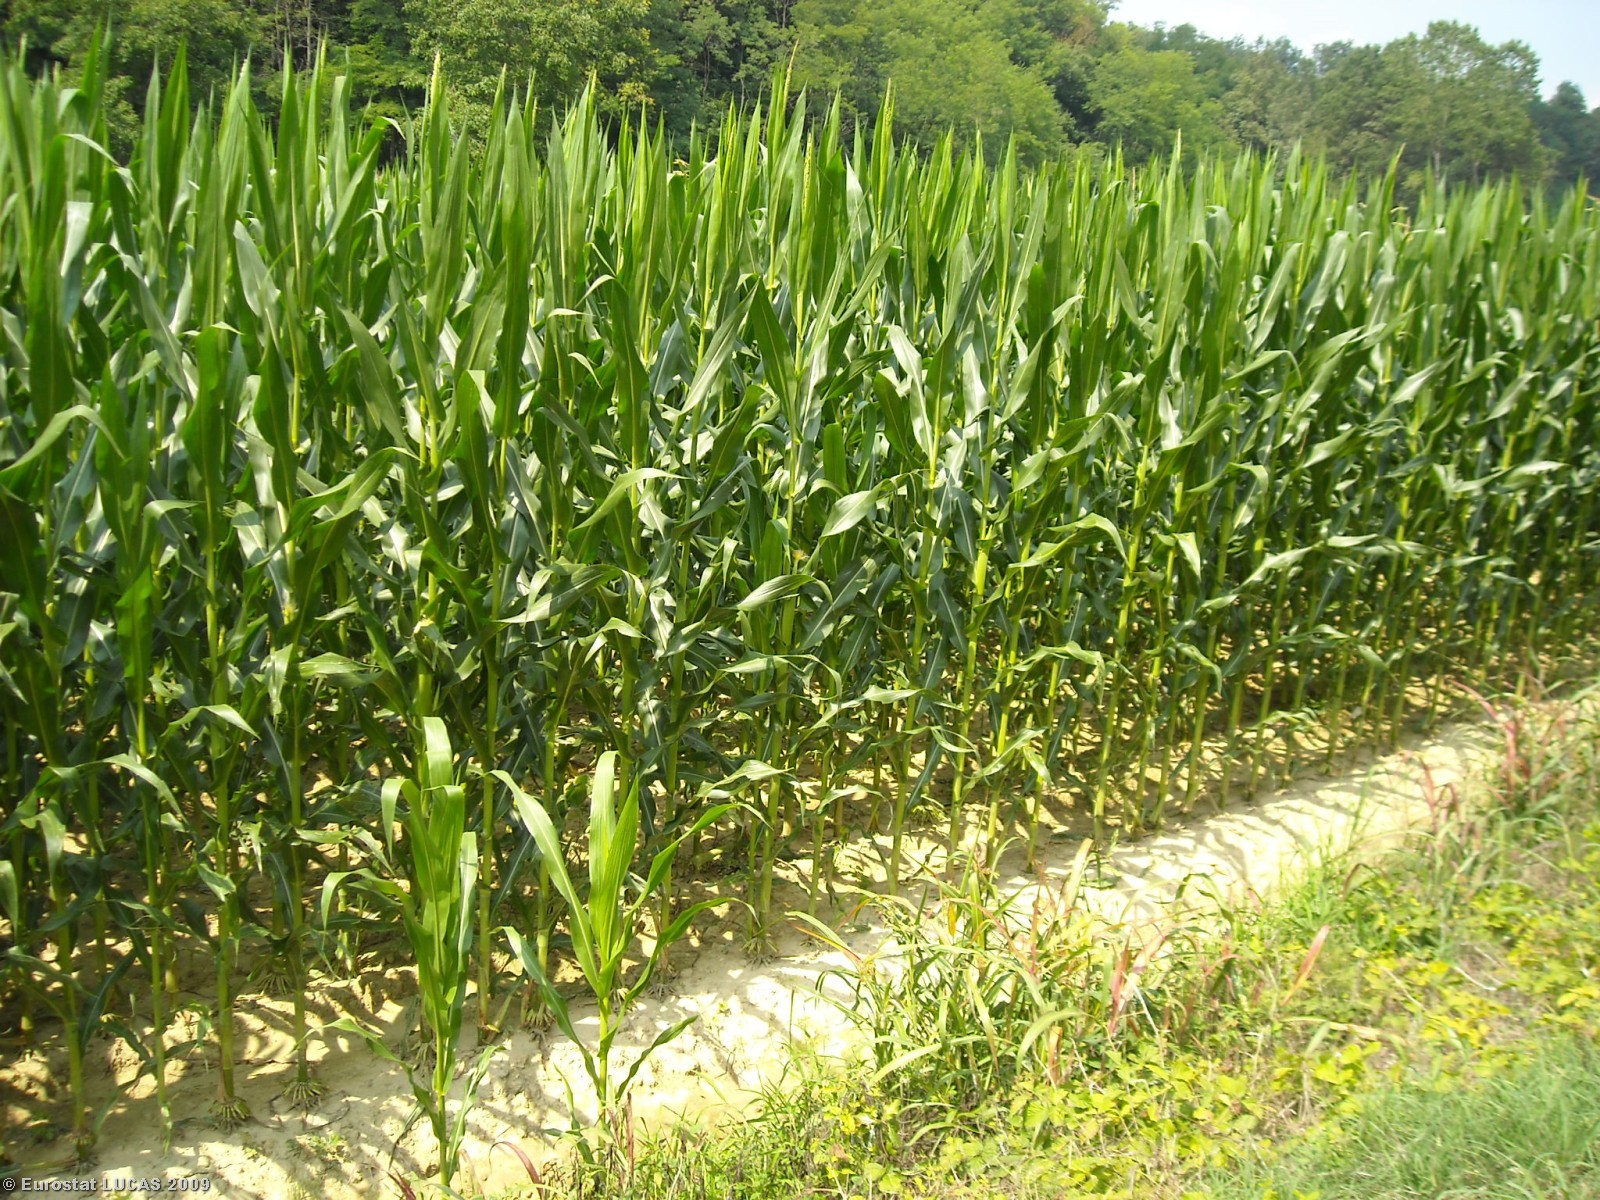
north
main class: Cropland
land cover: Maize
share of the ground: > 75 %
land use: Agriculture (excluding fallow land and kitchen gardens)
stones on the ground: < 10 %
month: July
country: IT
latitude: 44.9643
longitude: 8.0892
